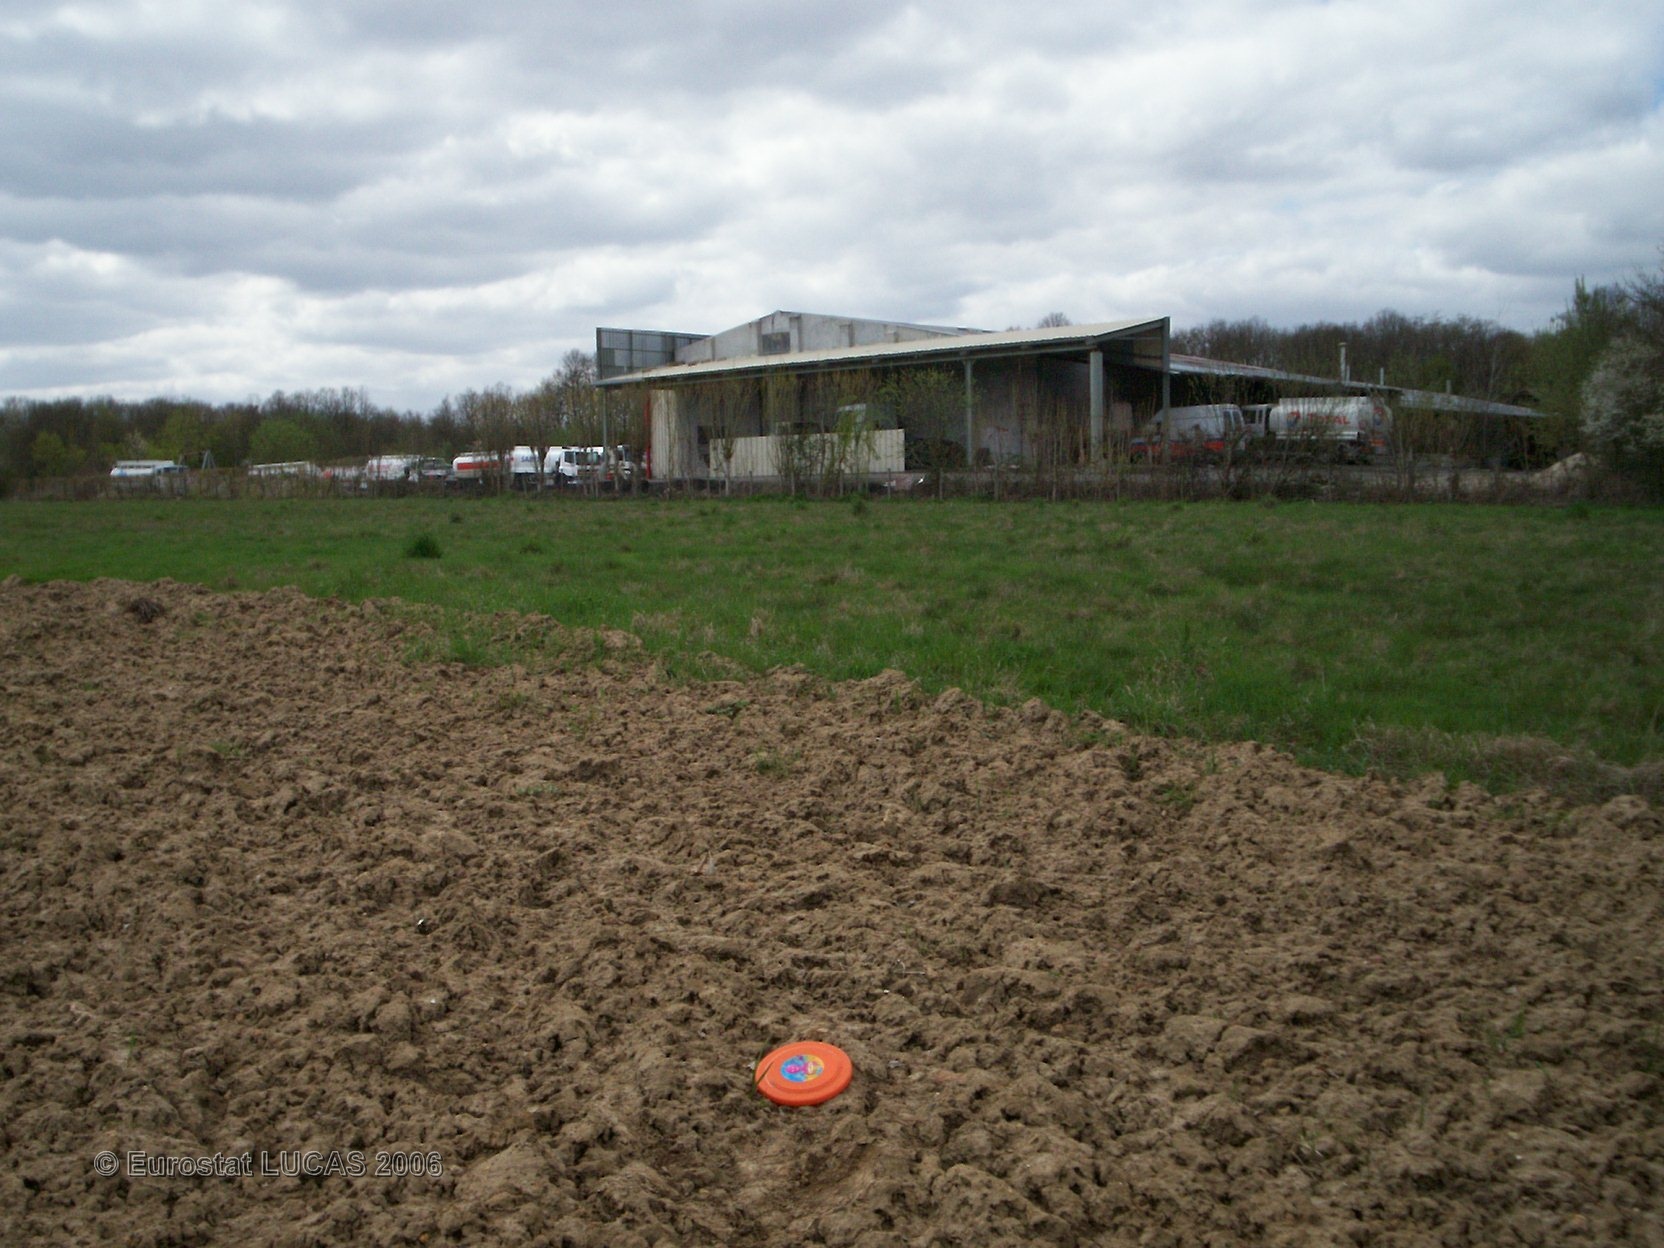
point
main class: Cropland
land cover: Maize
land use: Agriculture (excluding fallow land and kitchen gardens)
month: May
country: FR
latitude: 48.5530
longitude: 2.8786
